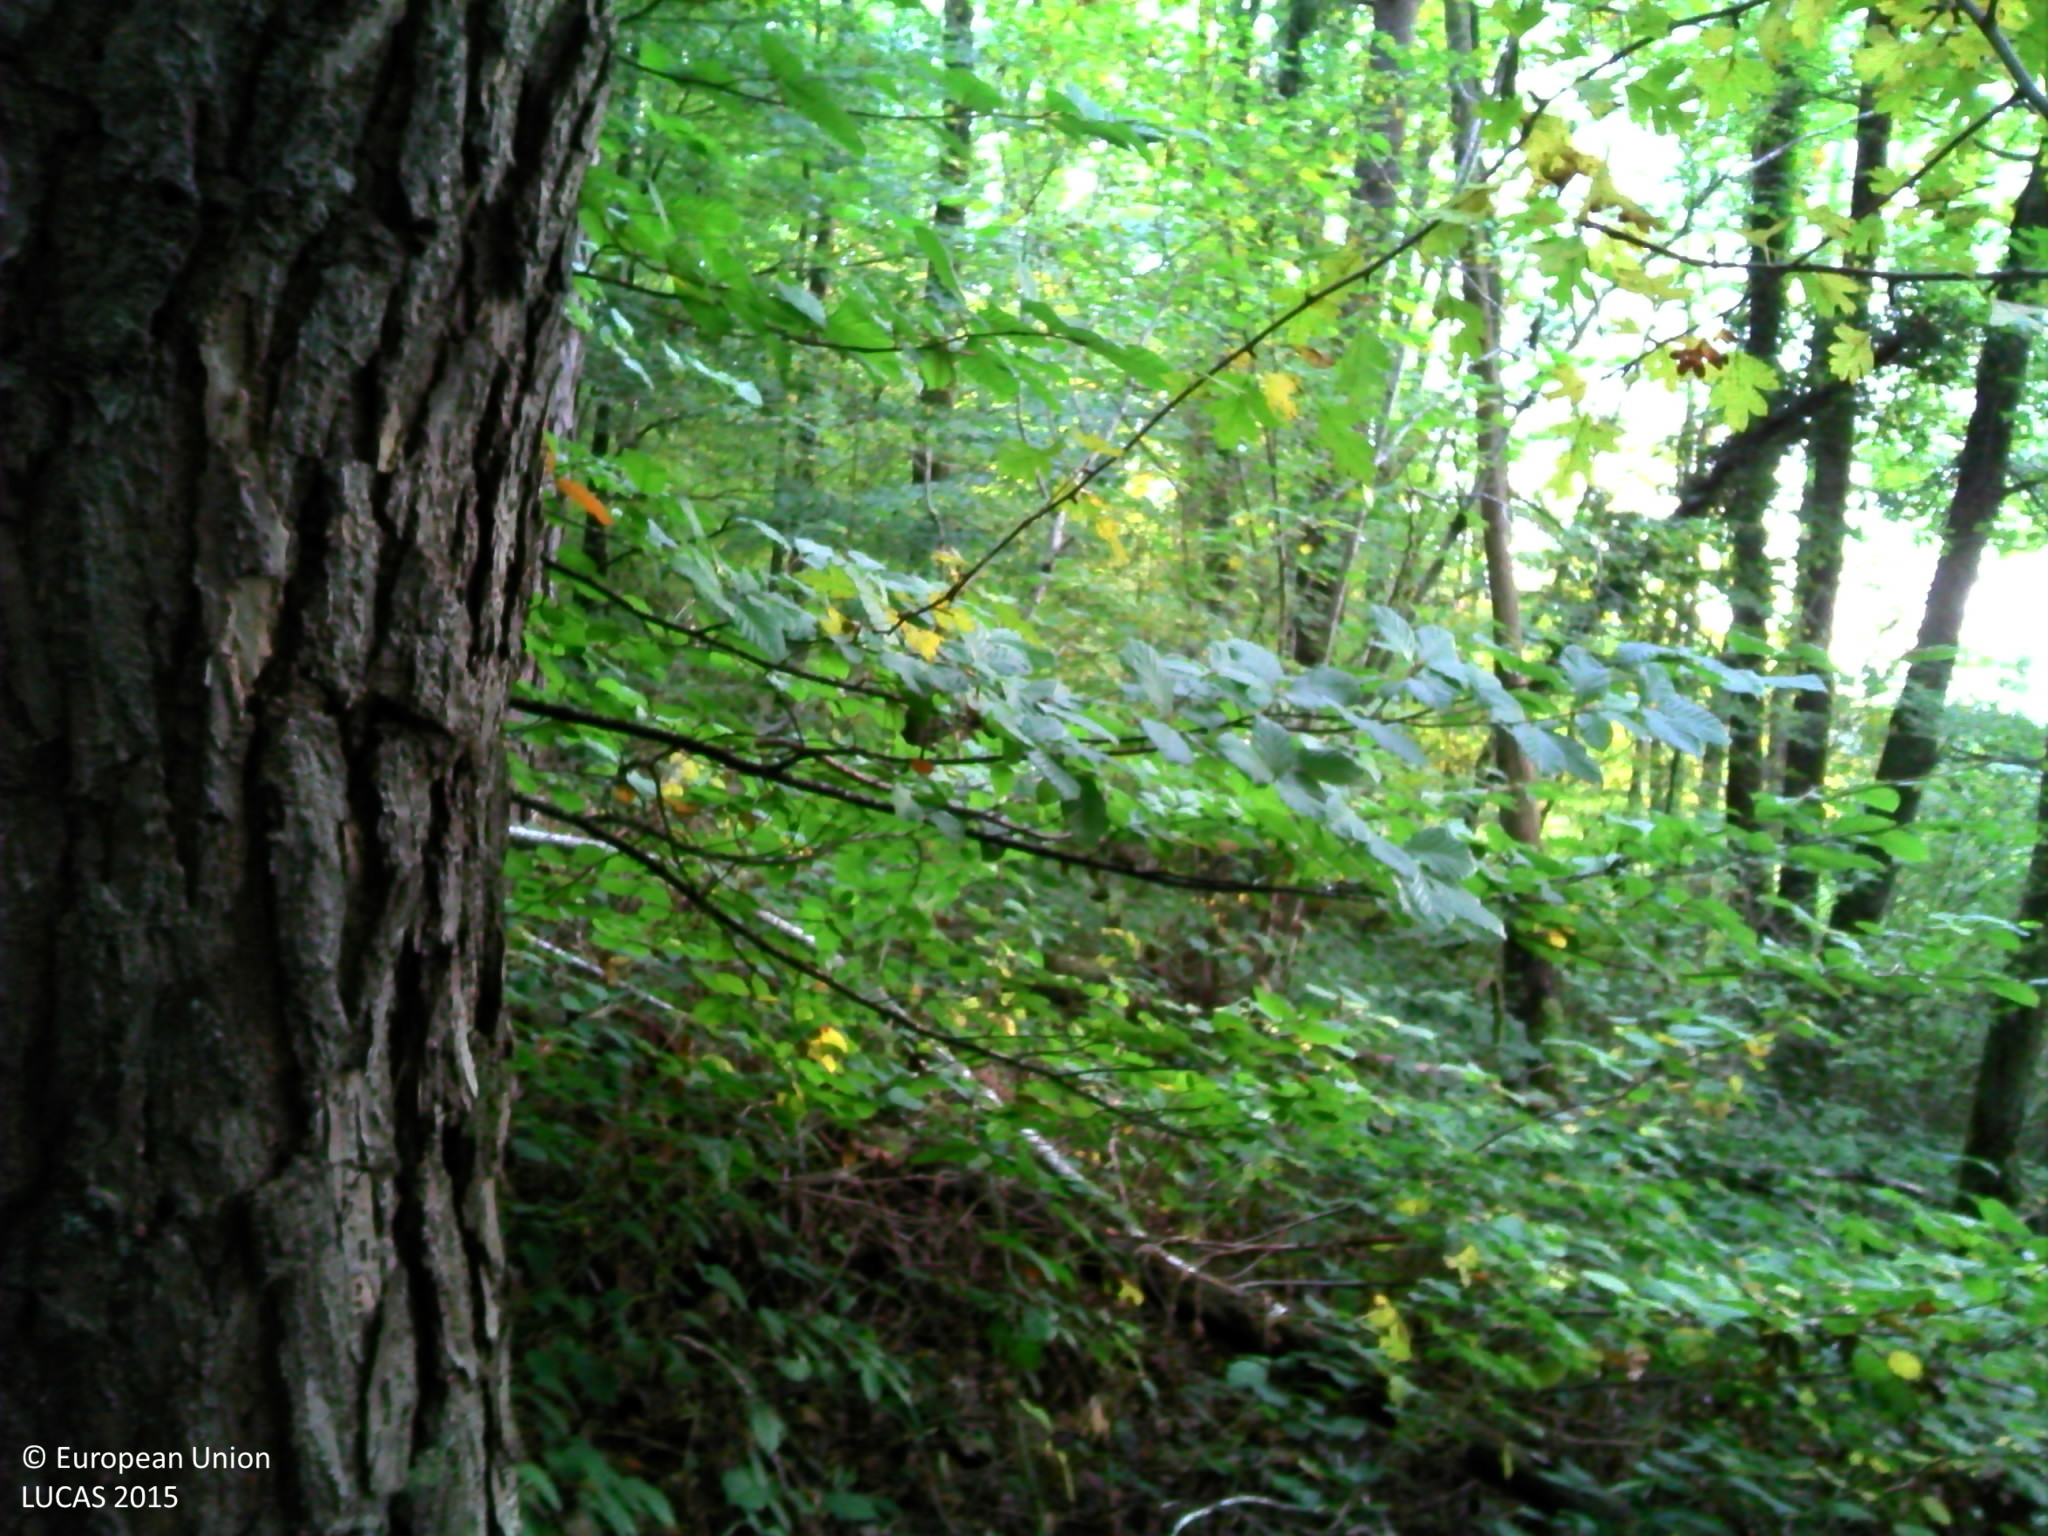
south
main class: Woodland
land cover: Broadleaved woodland
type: beech forest
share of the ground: > 75 %
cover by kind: broadleaved forest trees 90 %, shrubs 5 %, unconsolidated bare surface 5 %
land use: Forestry
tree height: > 5 m
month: October
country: FR
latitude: 47.1080
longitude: 6.0618
